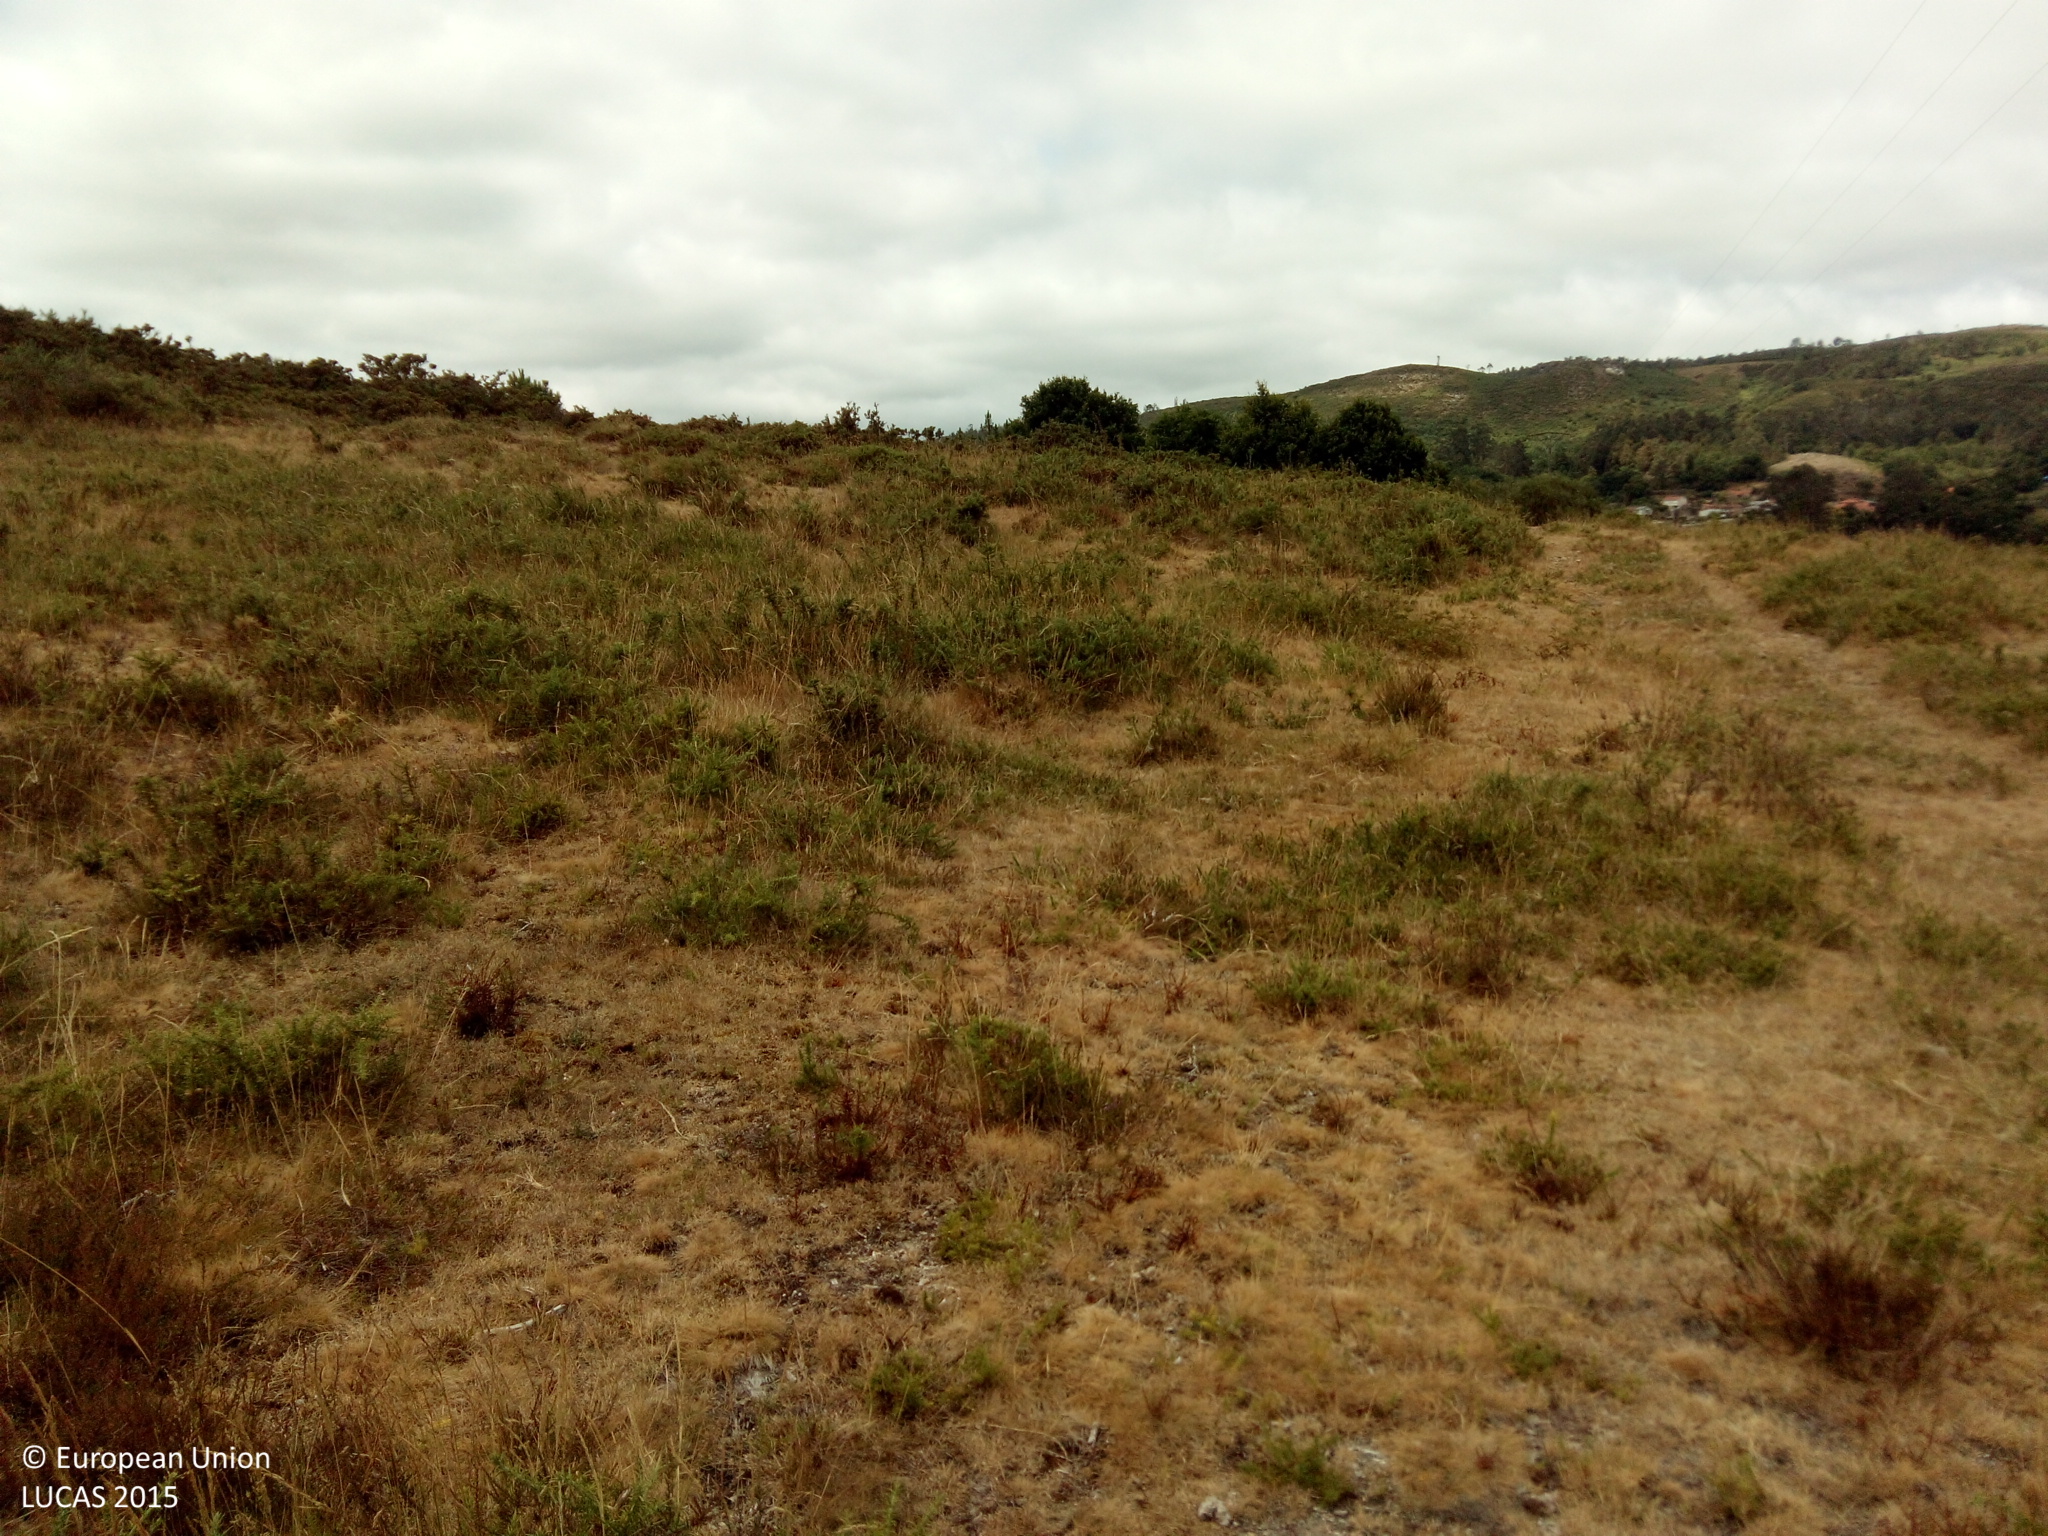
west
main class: Shrubland
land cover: Shrubland without tree cover
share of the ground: > 75 %
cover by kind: shrubs 100 %
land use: Abandoned areas
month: July
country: ES
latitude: 42.5491
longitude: -8.4496
